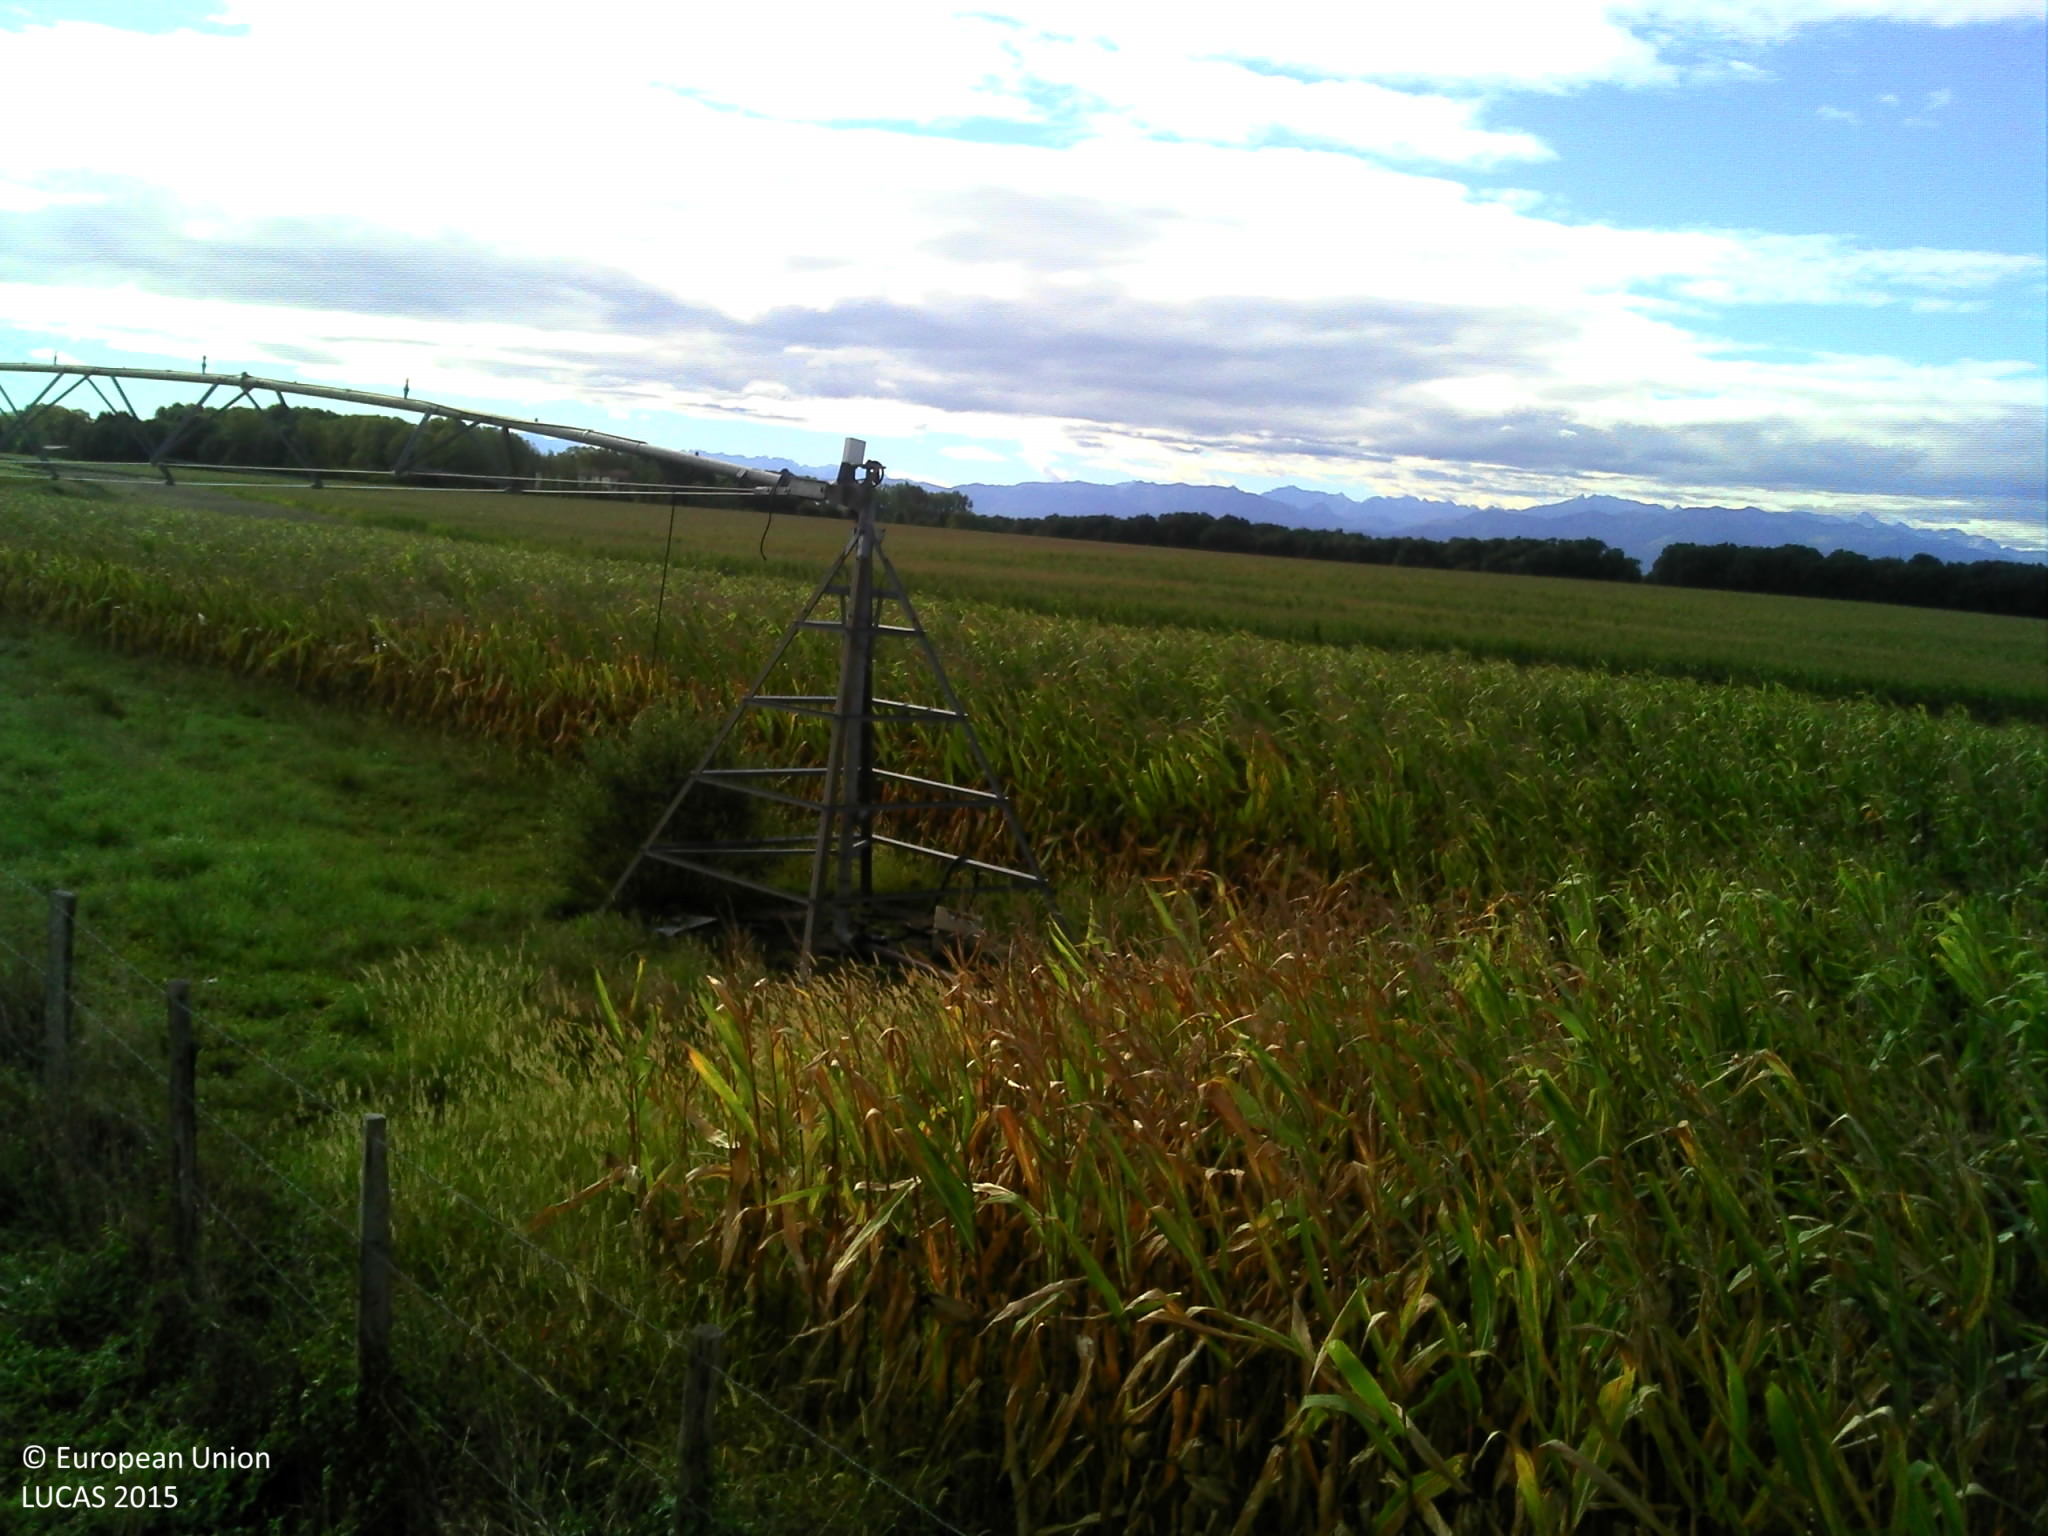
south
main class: Cropland
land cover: Maize
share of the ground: > 75 %
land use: Agriculture (excluding fallow land and kitchen gardens)
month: September
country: FR
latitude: 43.3532
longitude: -0.4081
